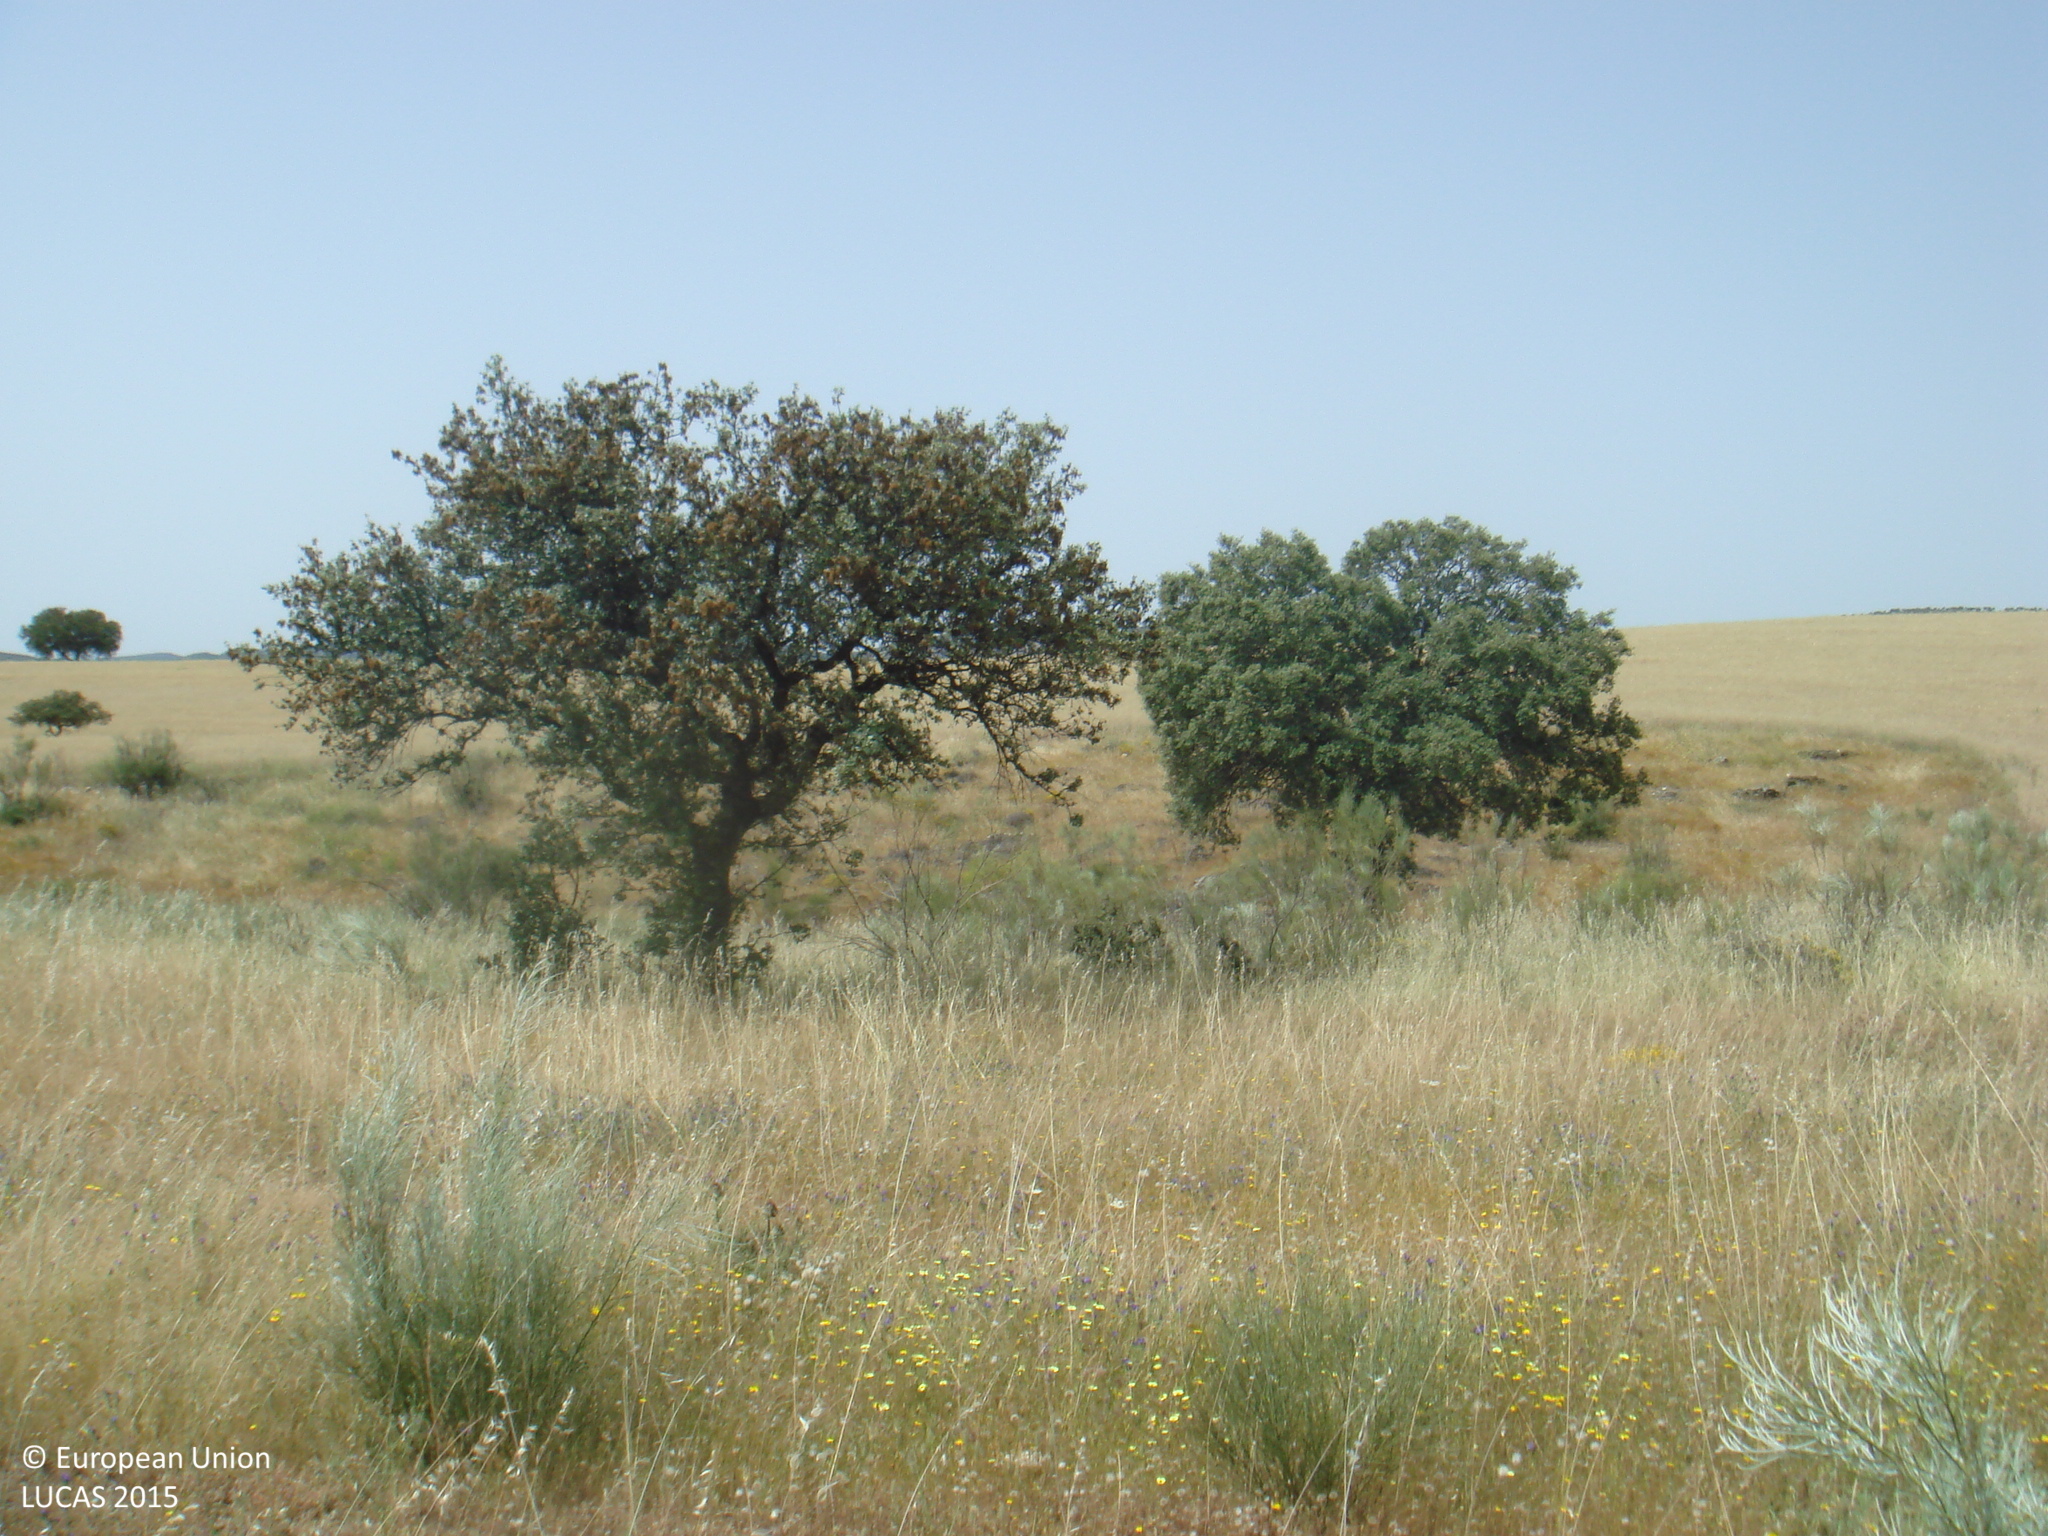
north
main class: Grassland
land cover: Grassland with sparse tree/shrub cover
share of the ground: > 75 %
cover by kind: herbaceous plants 95 %, broadleaved forest trees 5 %
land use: Agriculture (excluding fallow land and kitchen gardens)
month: May
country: ES
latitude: 38.5690
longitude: -4.7971
